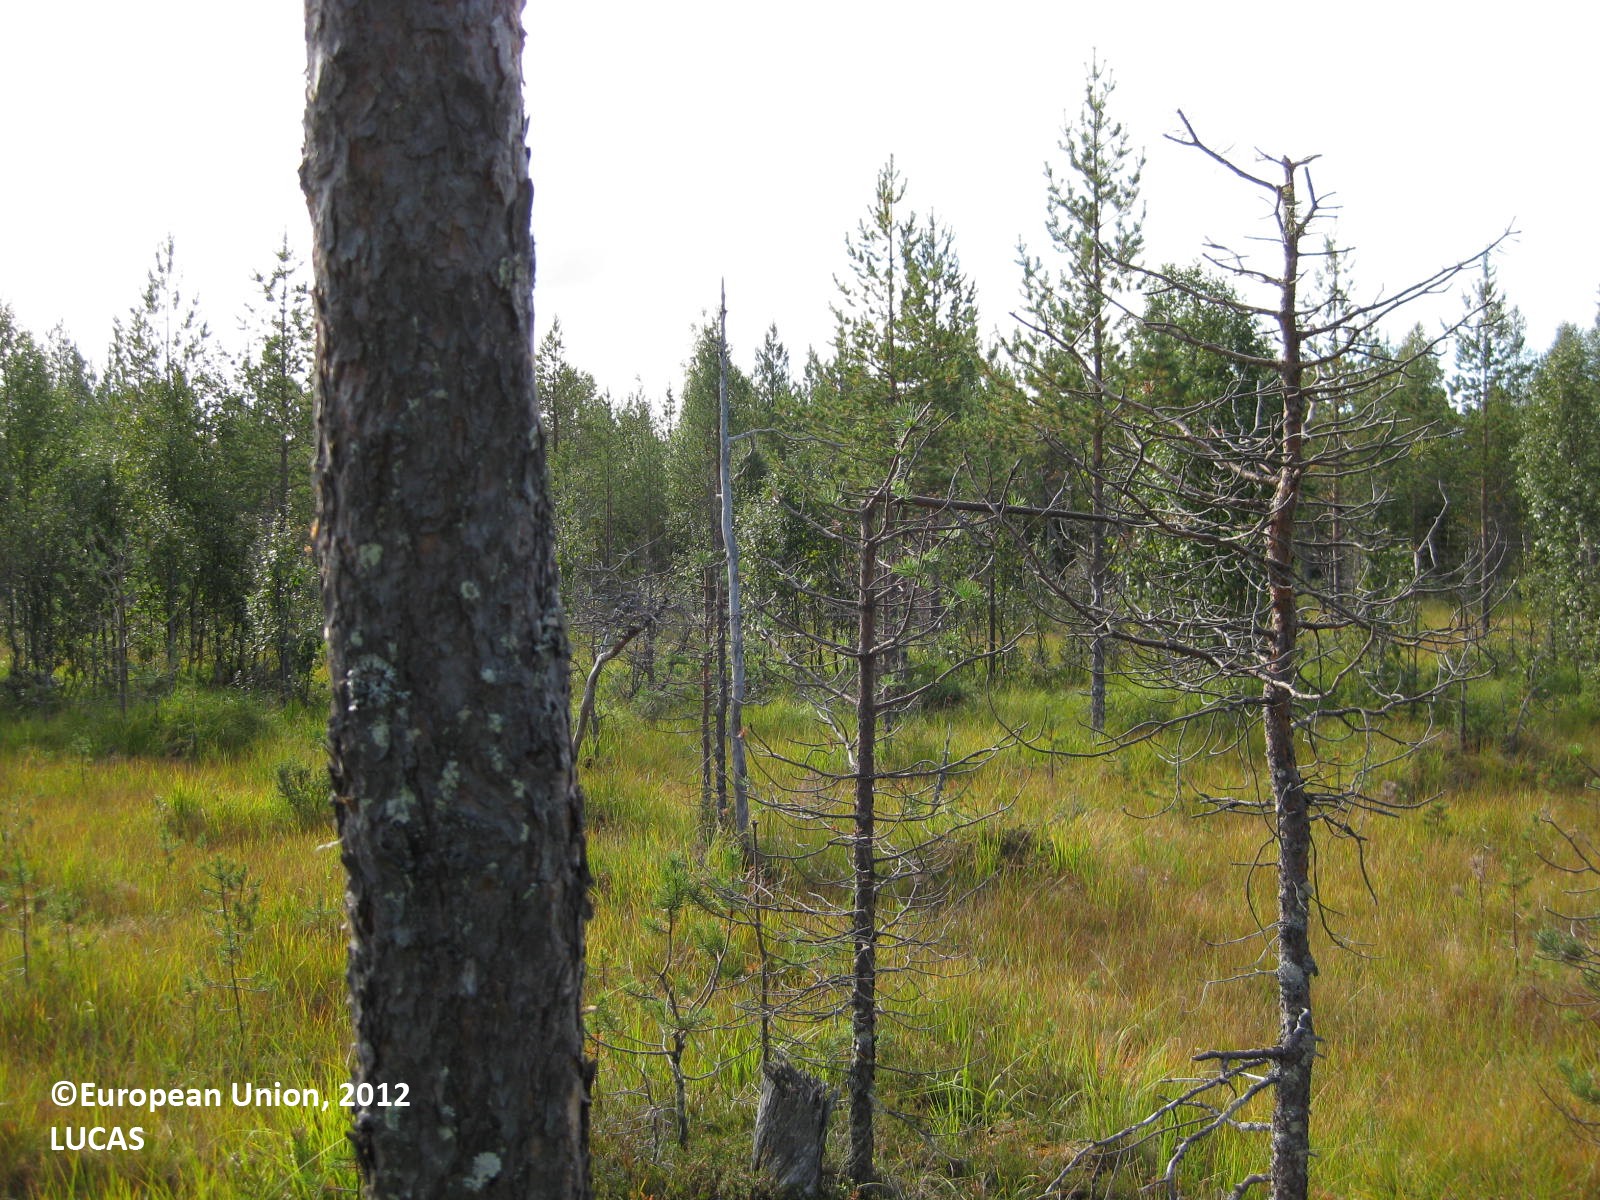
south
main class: Woodland
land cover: Pine dominated coniferous woodland
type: boreal forest
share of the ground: 25 - 50 %
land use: Forestry
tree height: > 5 m
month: August
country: FI
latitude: 66.2192
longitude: 29.7308
